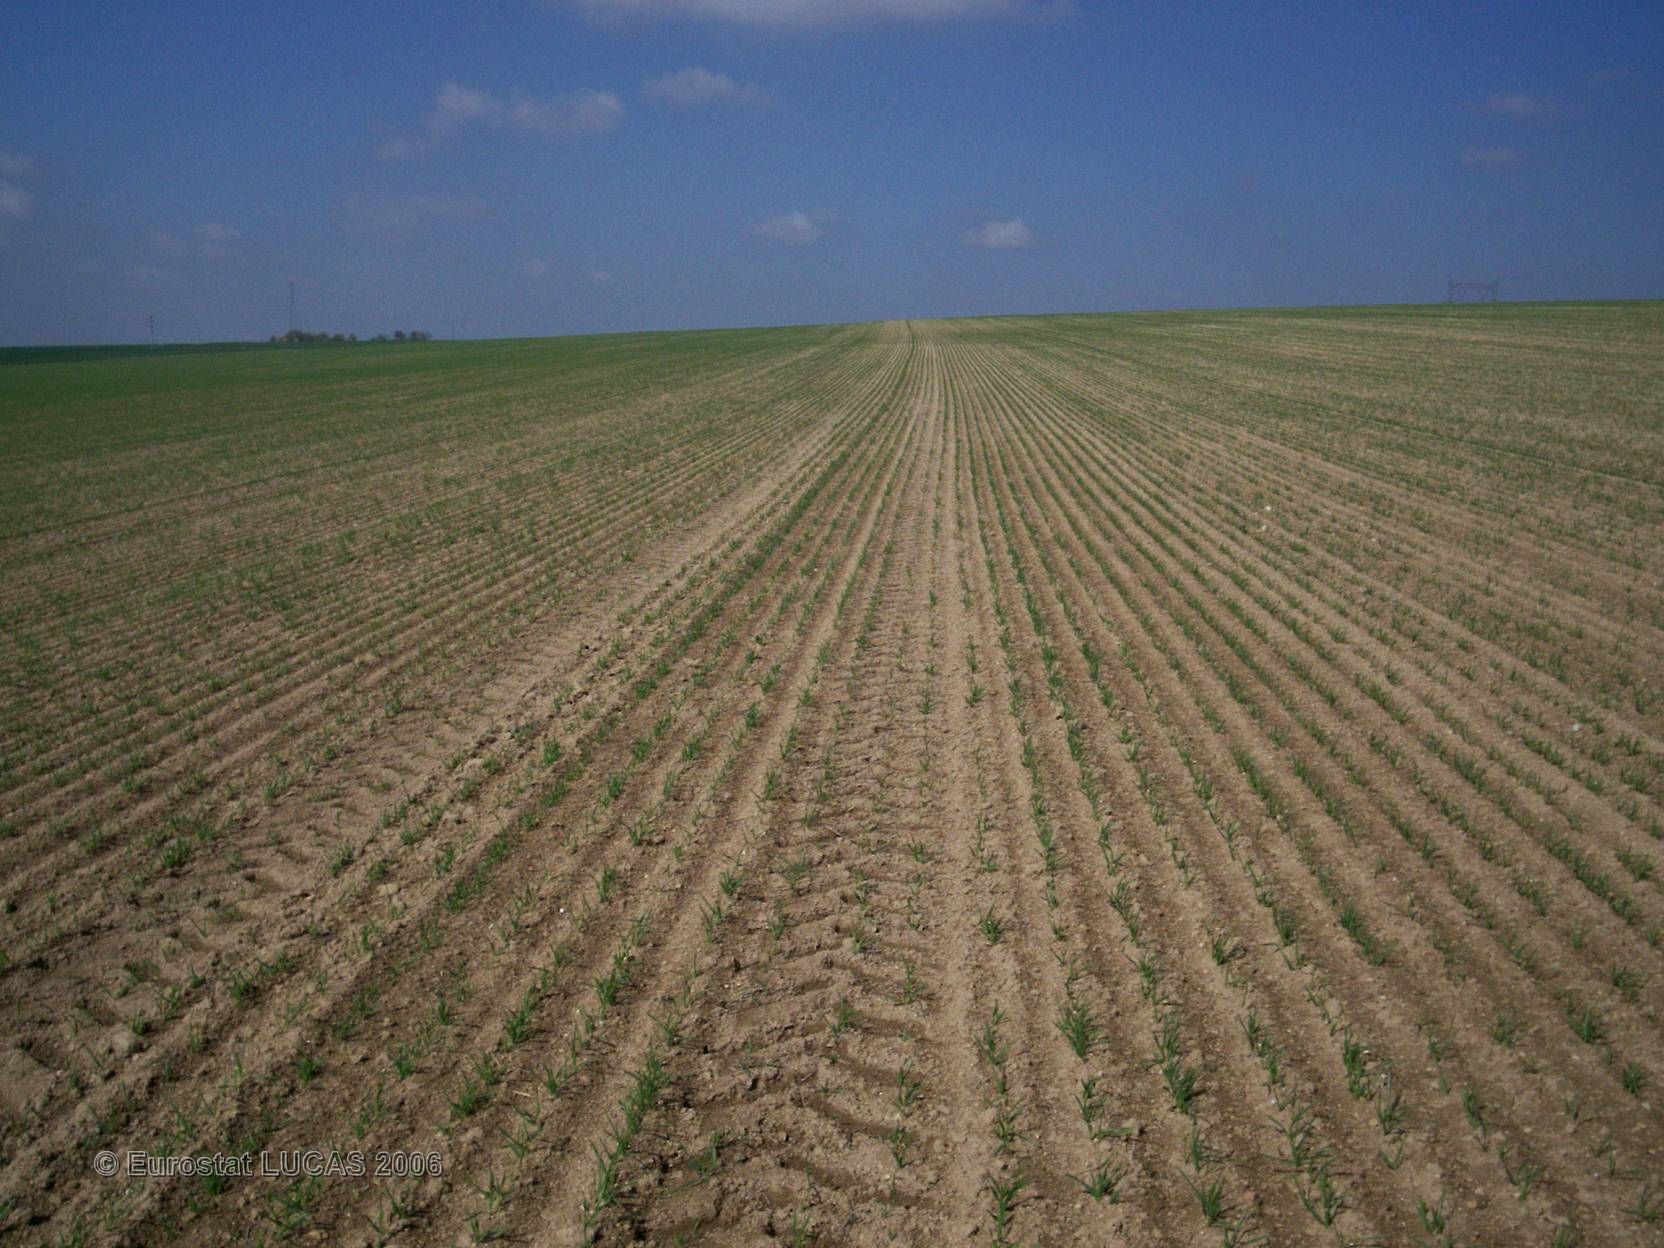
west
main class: Cropland
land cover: Barley
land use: Agriculture (excluding fallow land and kitchen gardens)
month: April
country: FR
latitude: 48.5198
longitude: 4.5140
